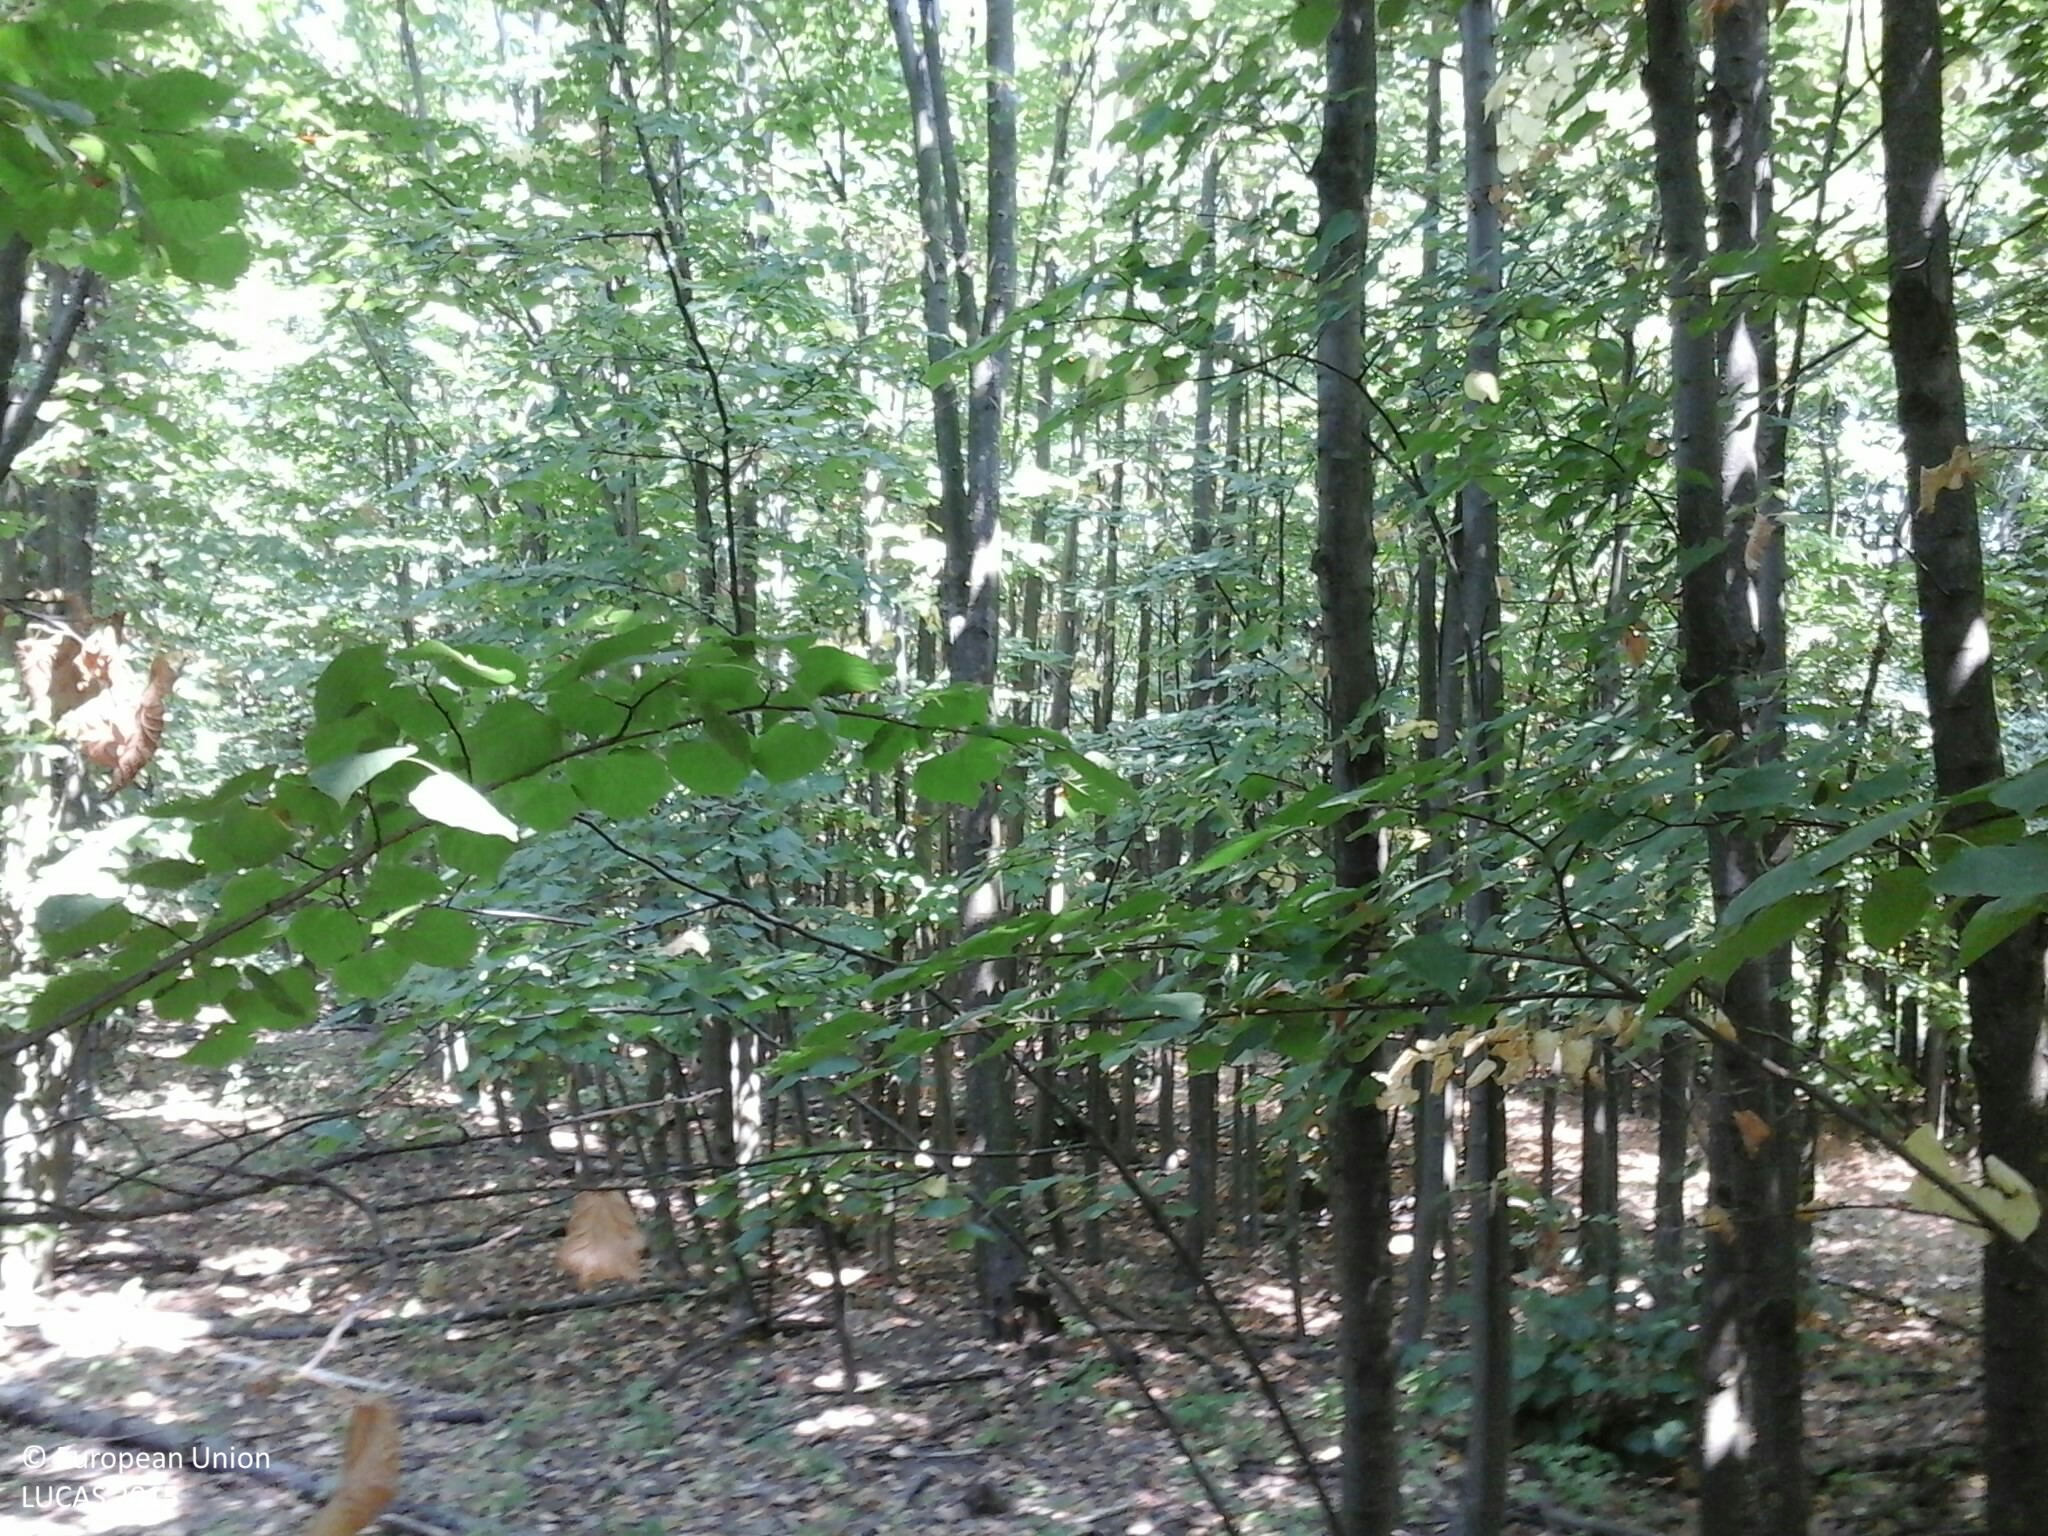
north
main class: Woodland
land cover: Broadleaved woodland
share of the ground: > 75 %
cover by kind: broadleaved forest trees 100 %
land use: Forestry
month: August
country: HU
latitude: 46.9214
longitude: 18.2176
